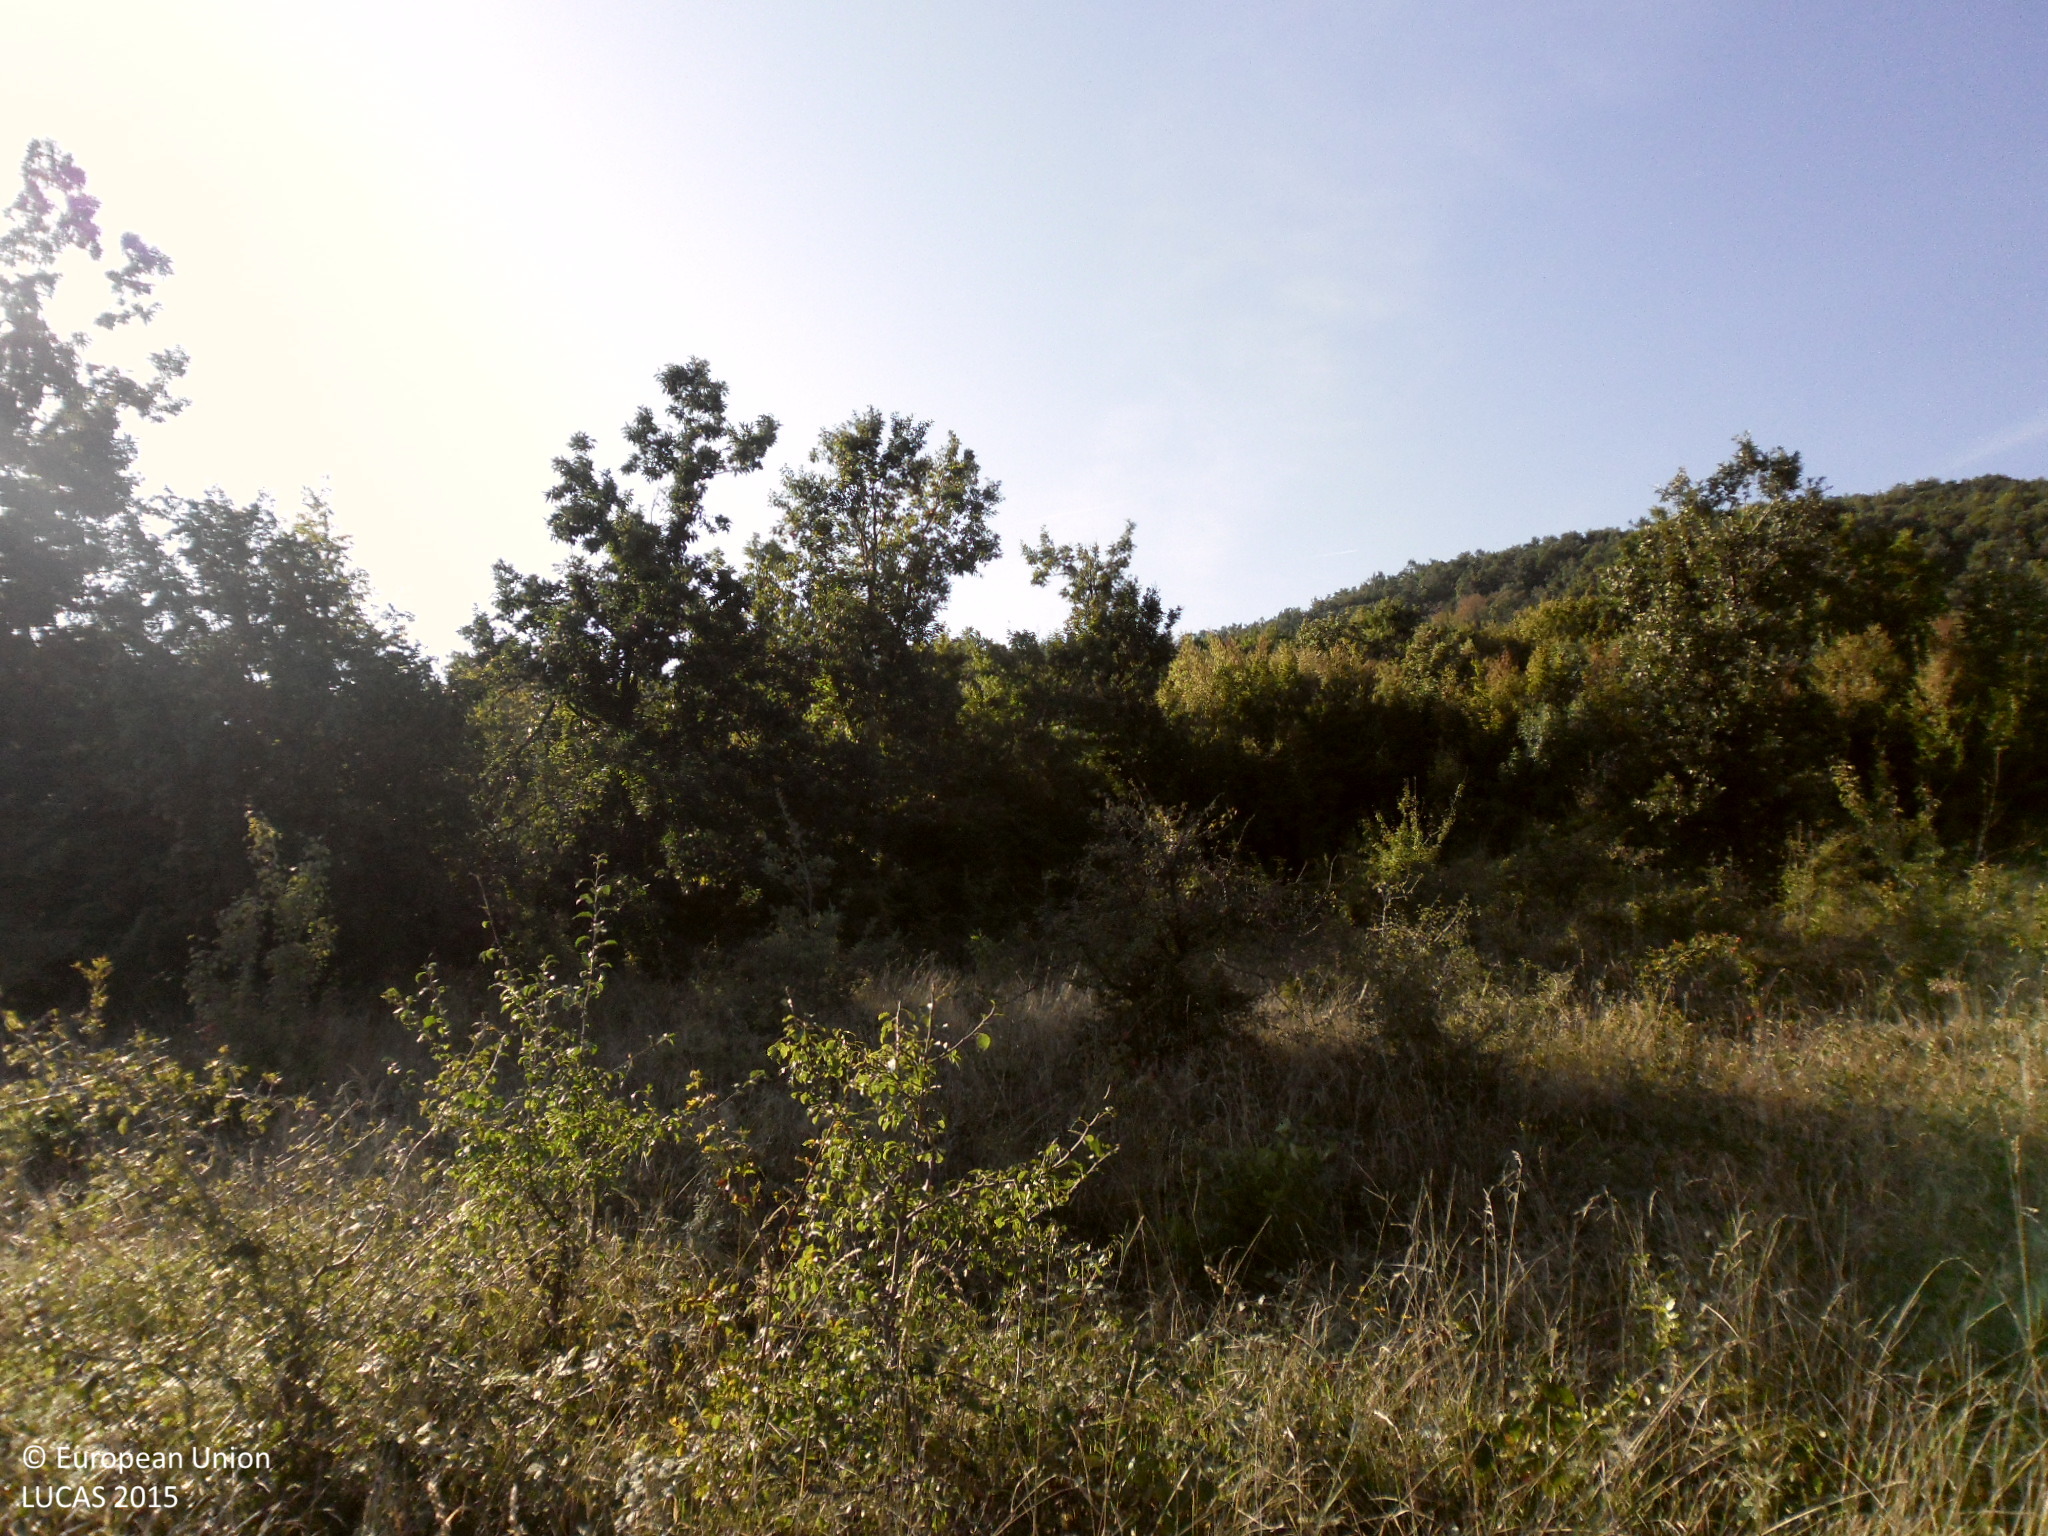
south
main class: Grassland
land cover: Grassland with sparse tree/shrub cover
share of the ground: > 75 %
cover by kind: herbaceous plants 90 %, broadleaved forest trees 5 %, shrubs 5 %
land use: Semi-natural and natural areas not in use
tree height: < 5 m
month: October
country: BG
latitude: 43.5839
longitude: 22.8540
